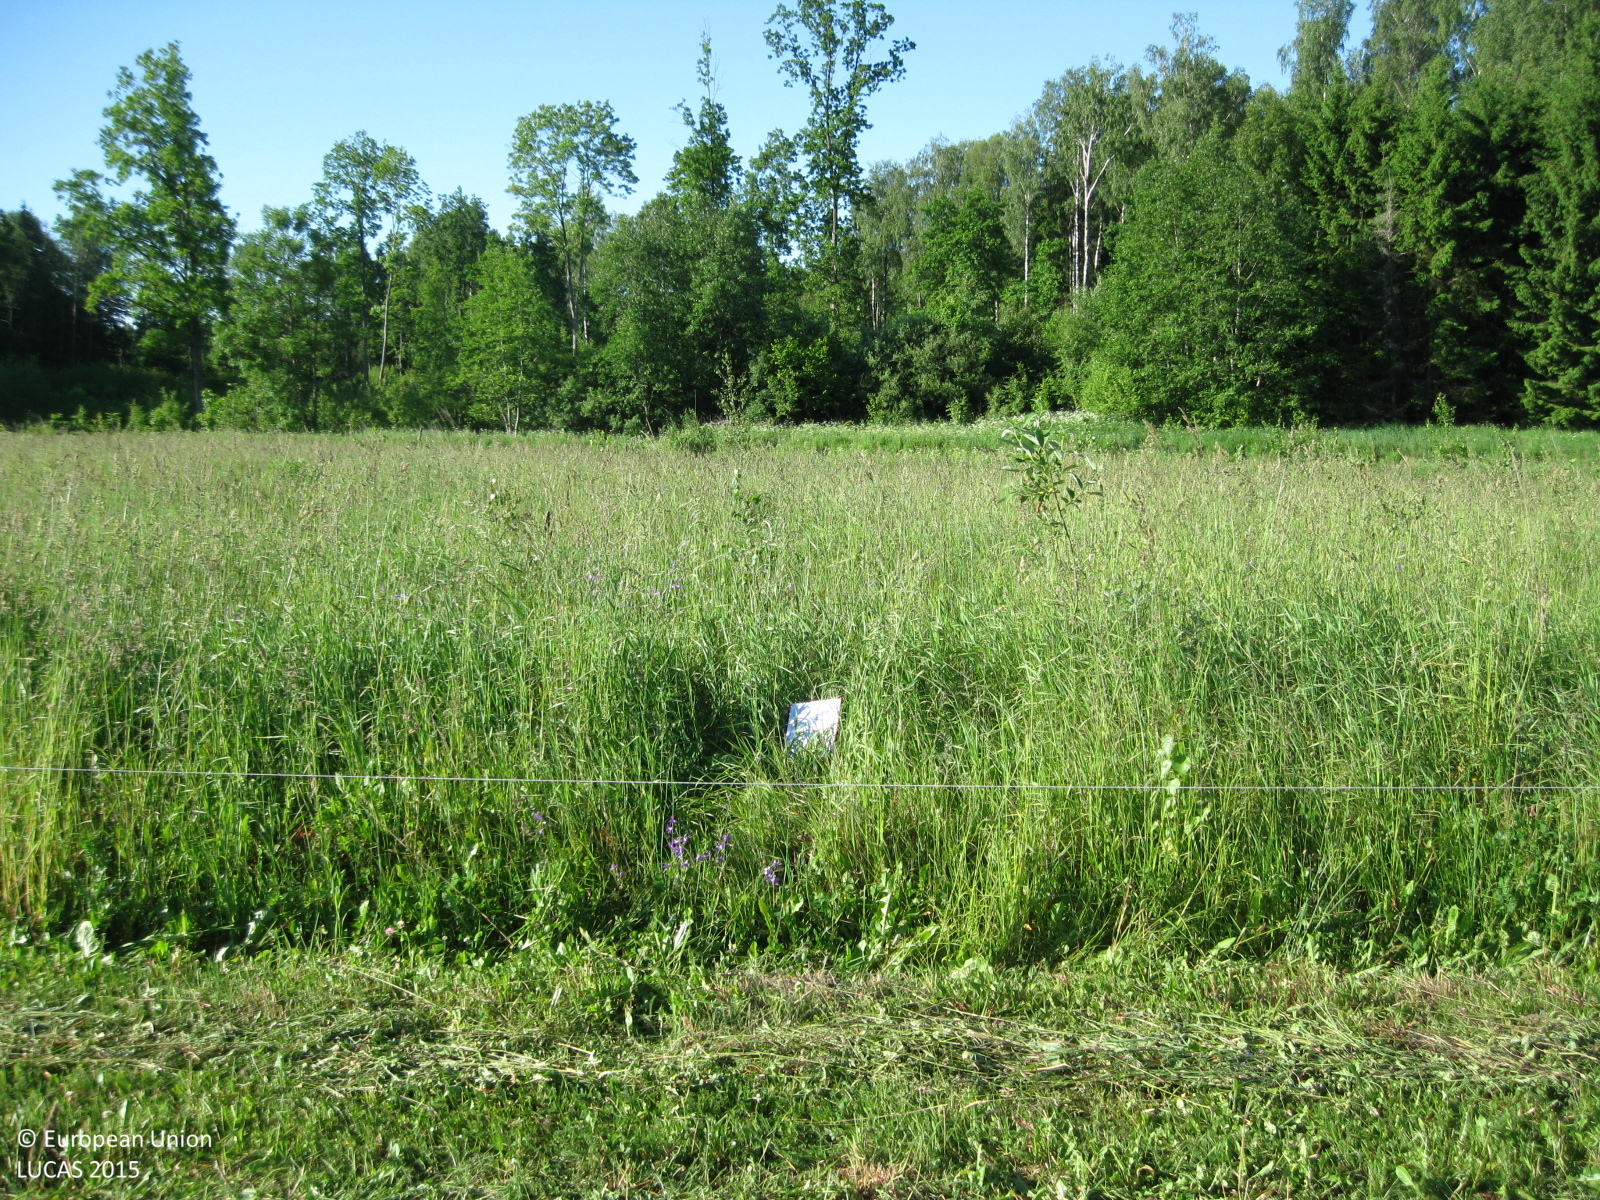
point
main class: Grassland
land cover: Grassland without tree/shrub cover
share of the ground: > 75 %
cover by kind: herbaceous plants 100 %
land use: Agriculture (excluding fallow land and kitchen gardens)
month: June
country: LT
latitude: 55.3505
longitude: 23.7581
